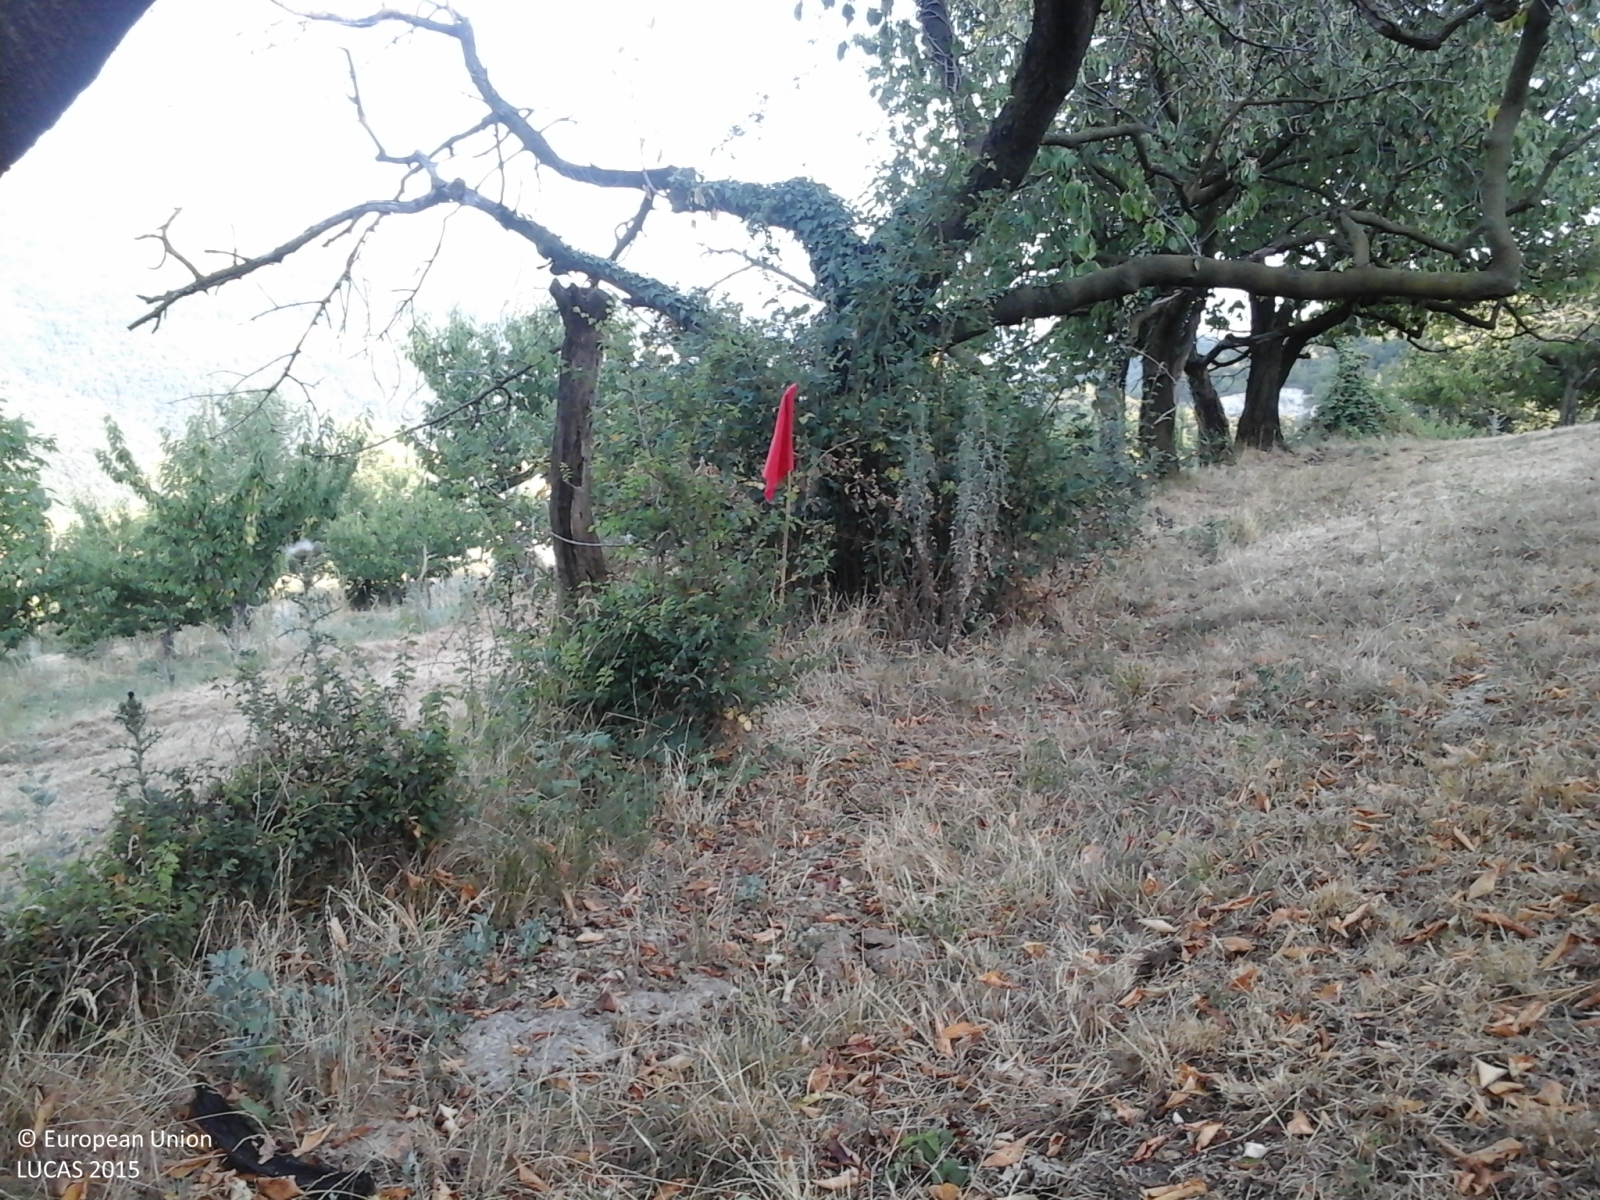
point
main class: Cropland
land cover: Cherry fruit
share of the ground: 50 - 75 %
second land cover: Grassland without tree/shrub cover
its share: > 75 %
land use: Agriculture (excluding fallow land and kitchen gardens)
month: July
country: IT
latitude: 45.5719
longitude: 10.9850
